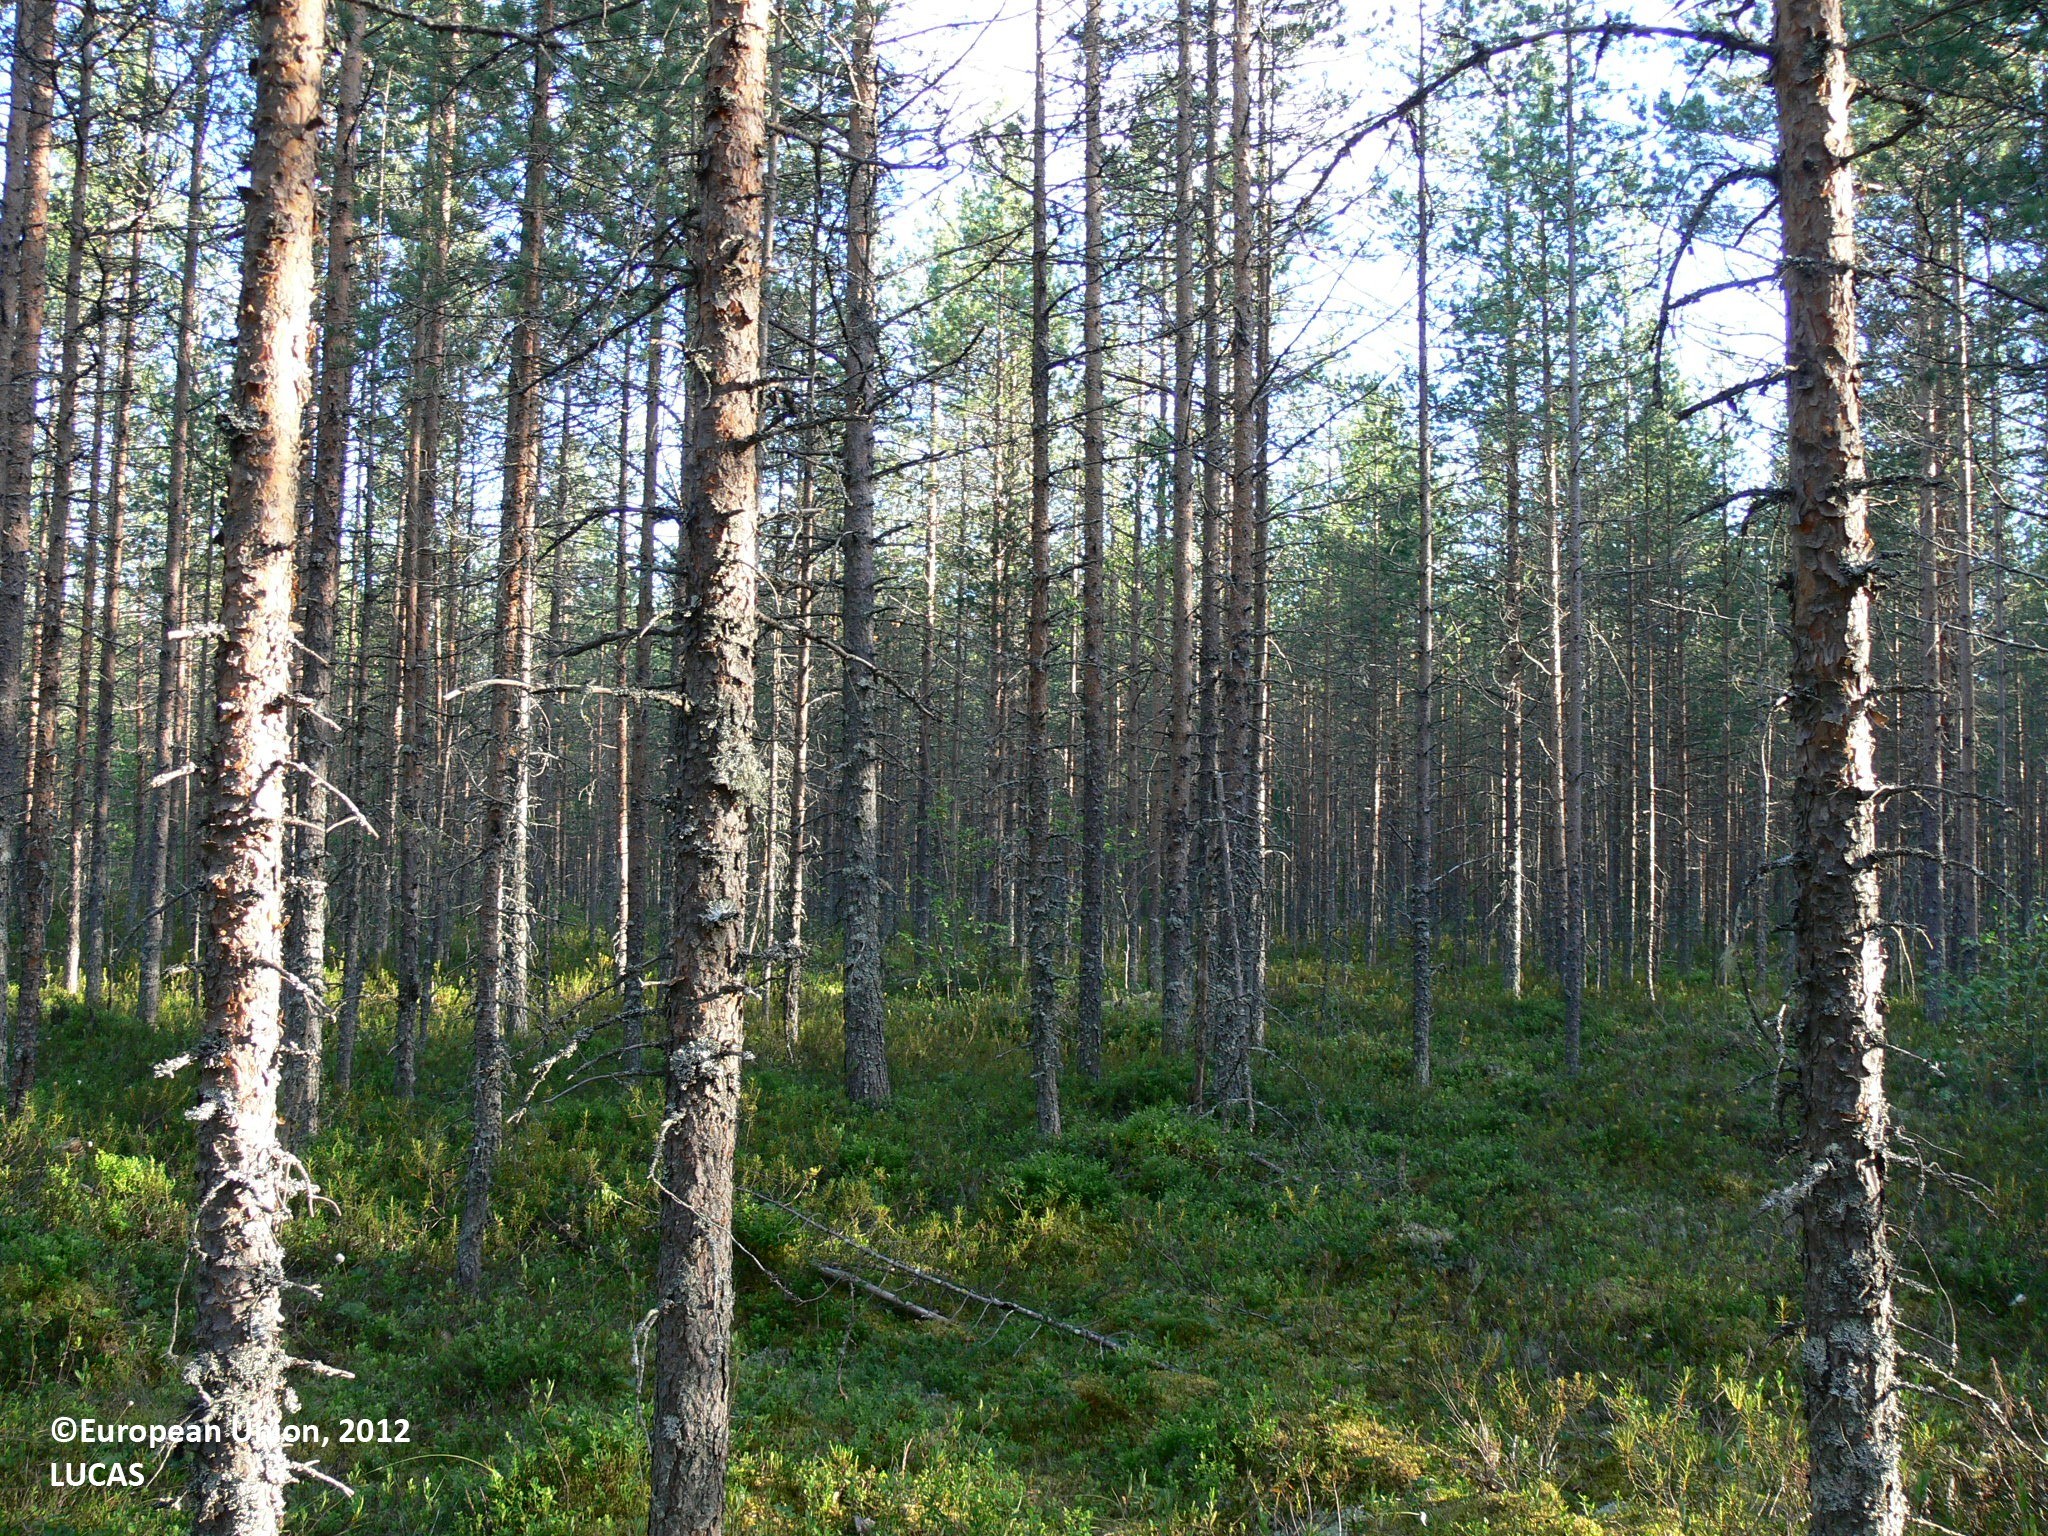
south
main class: Woodland
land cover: Pine dominated coniferous woodland
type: boreal forest
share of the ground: > 75 %
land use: Forestry
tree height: > 5 m
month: July
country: FI
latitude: 62.9037
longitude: 31.0238
